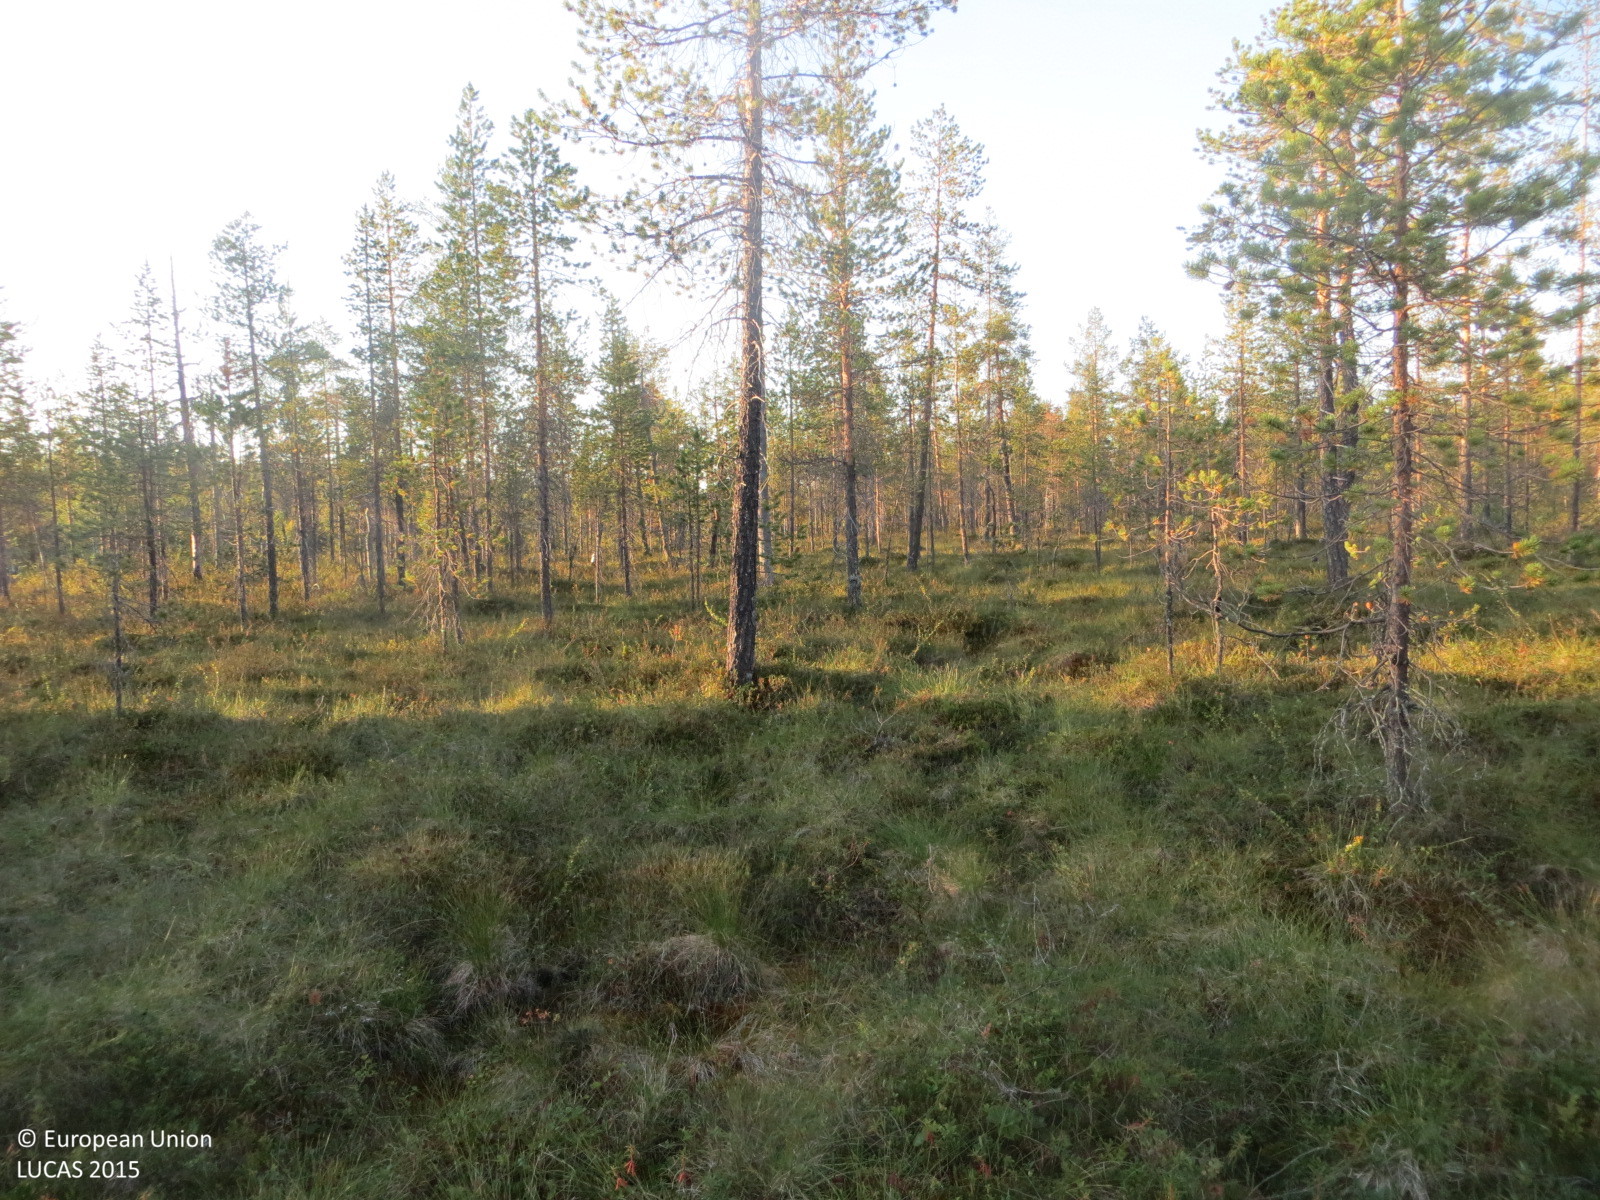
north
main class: Woodland
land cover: Pine dominated coniferous woodland
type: mire and swamp forests
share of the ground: 50 - 75 %
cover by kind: coniferous forest trees 50 %, shrubs 40 %, herbaceous plants 10 %
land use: Forestry
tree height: > 5 m
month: August
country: FI
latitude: 67.7373
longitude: 24.4788
